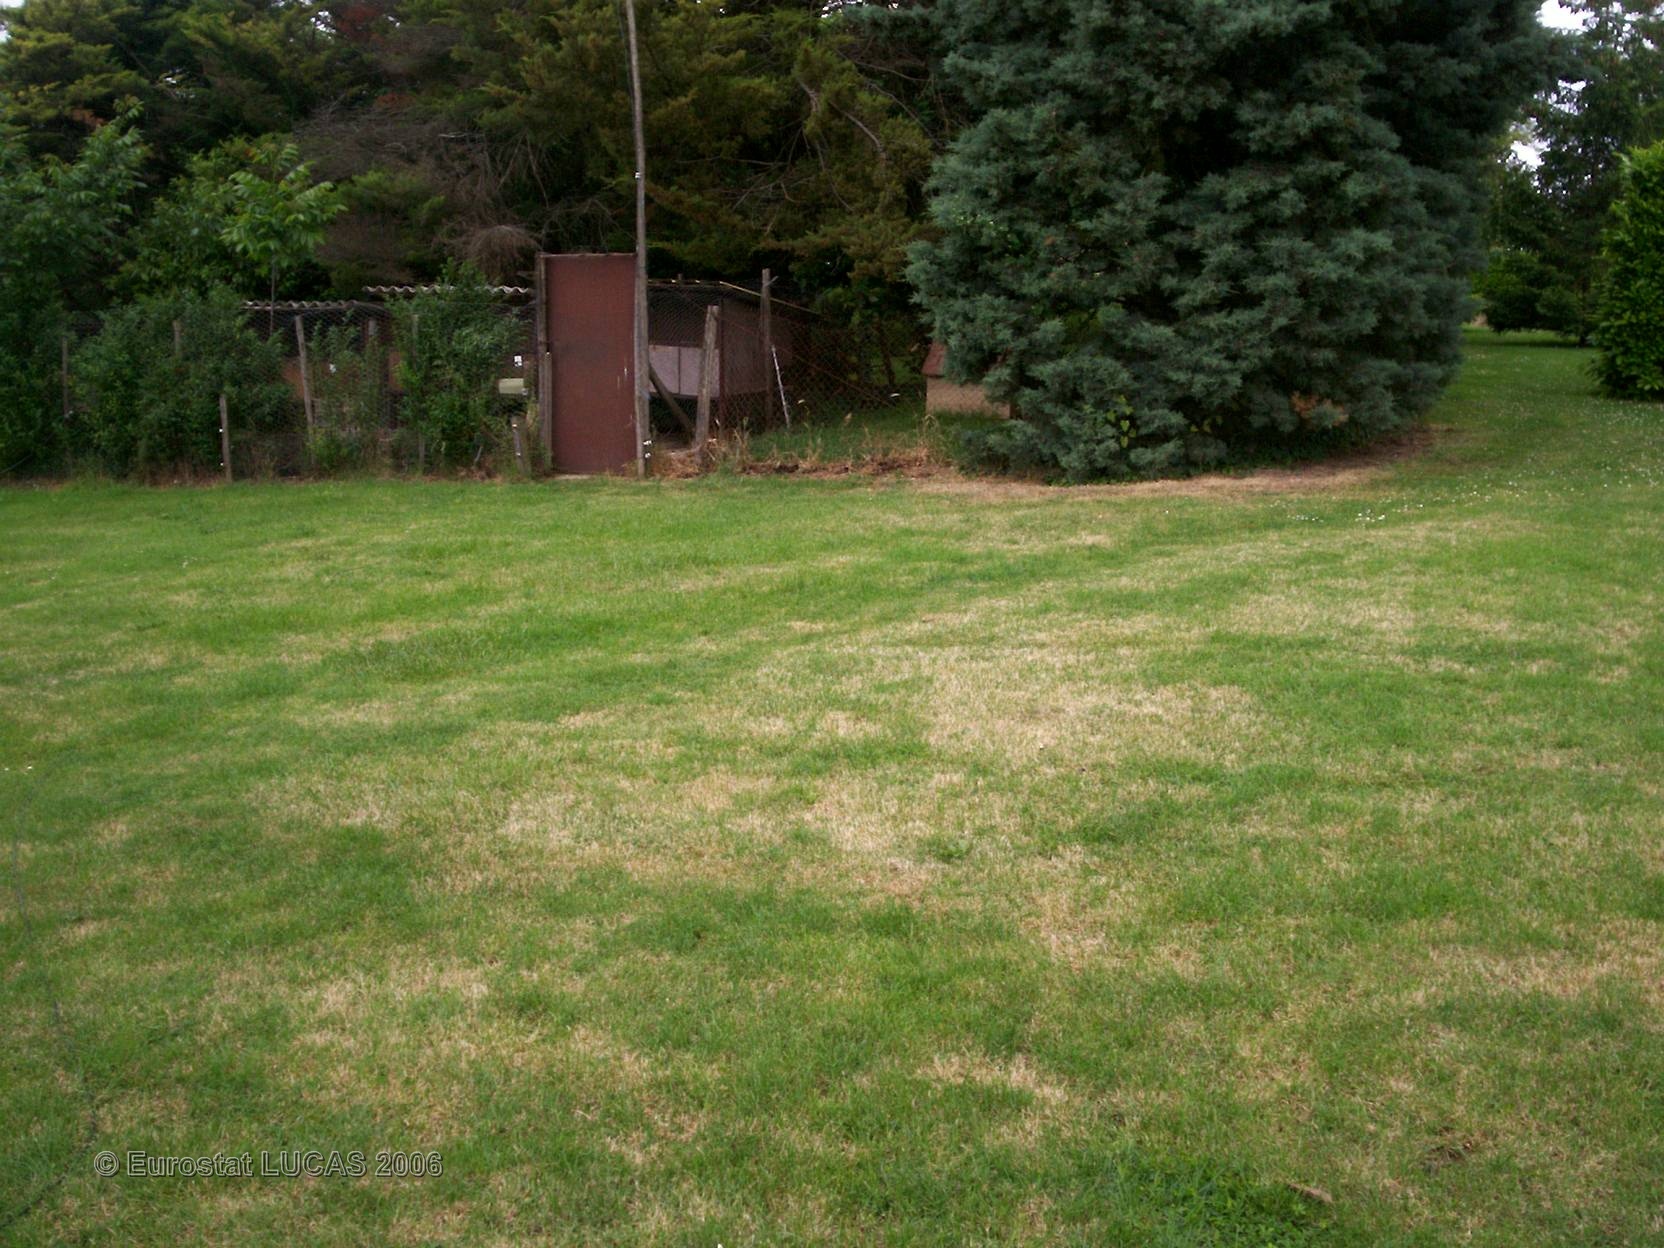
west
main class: Grassland
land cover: Grassland without tree/shrub cover
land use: Residential
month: May
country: FR
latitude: 43.6292
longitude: 0.9648
